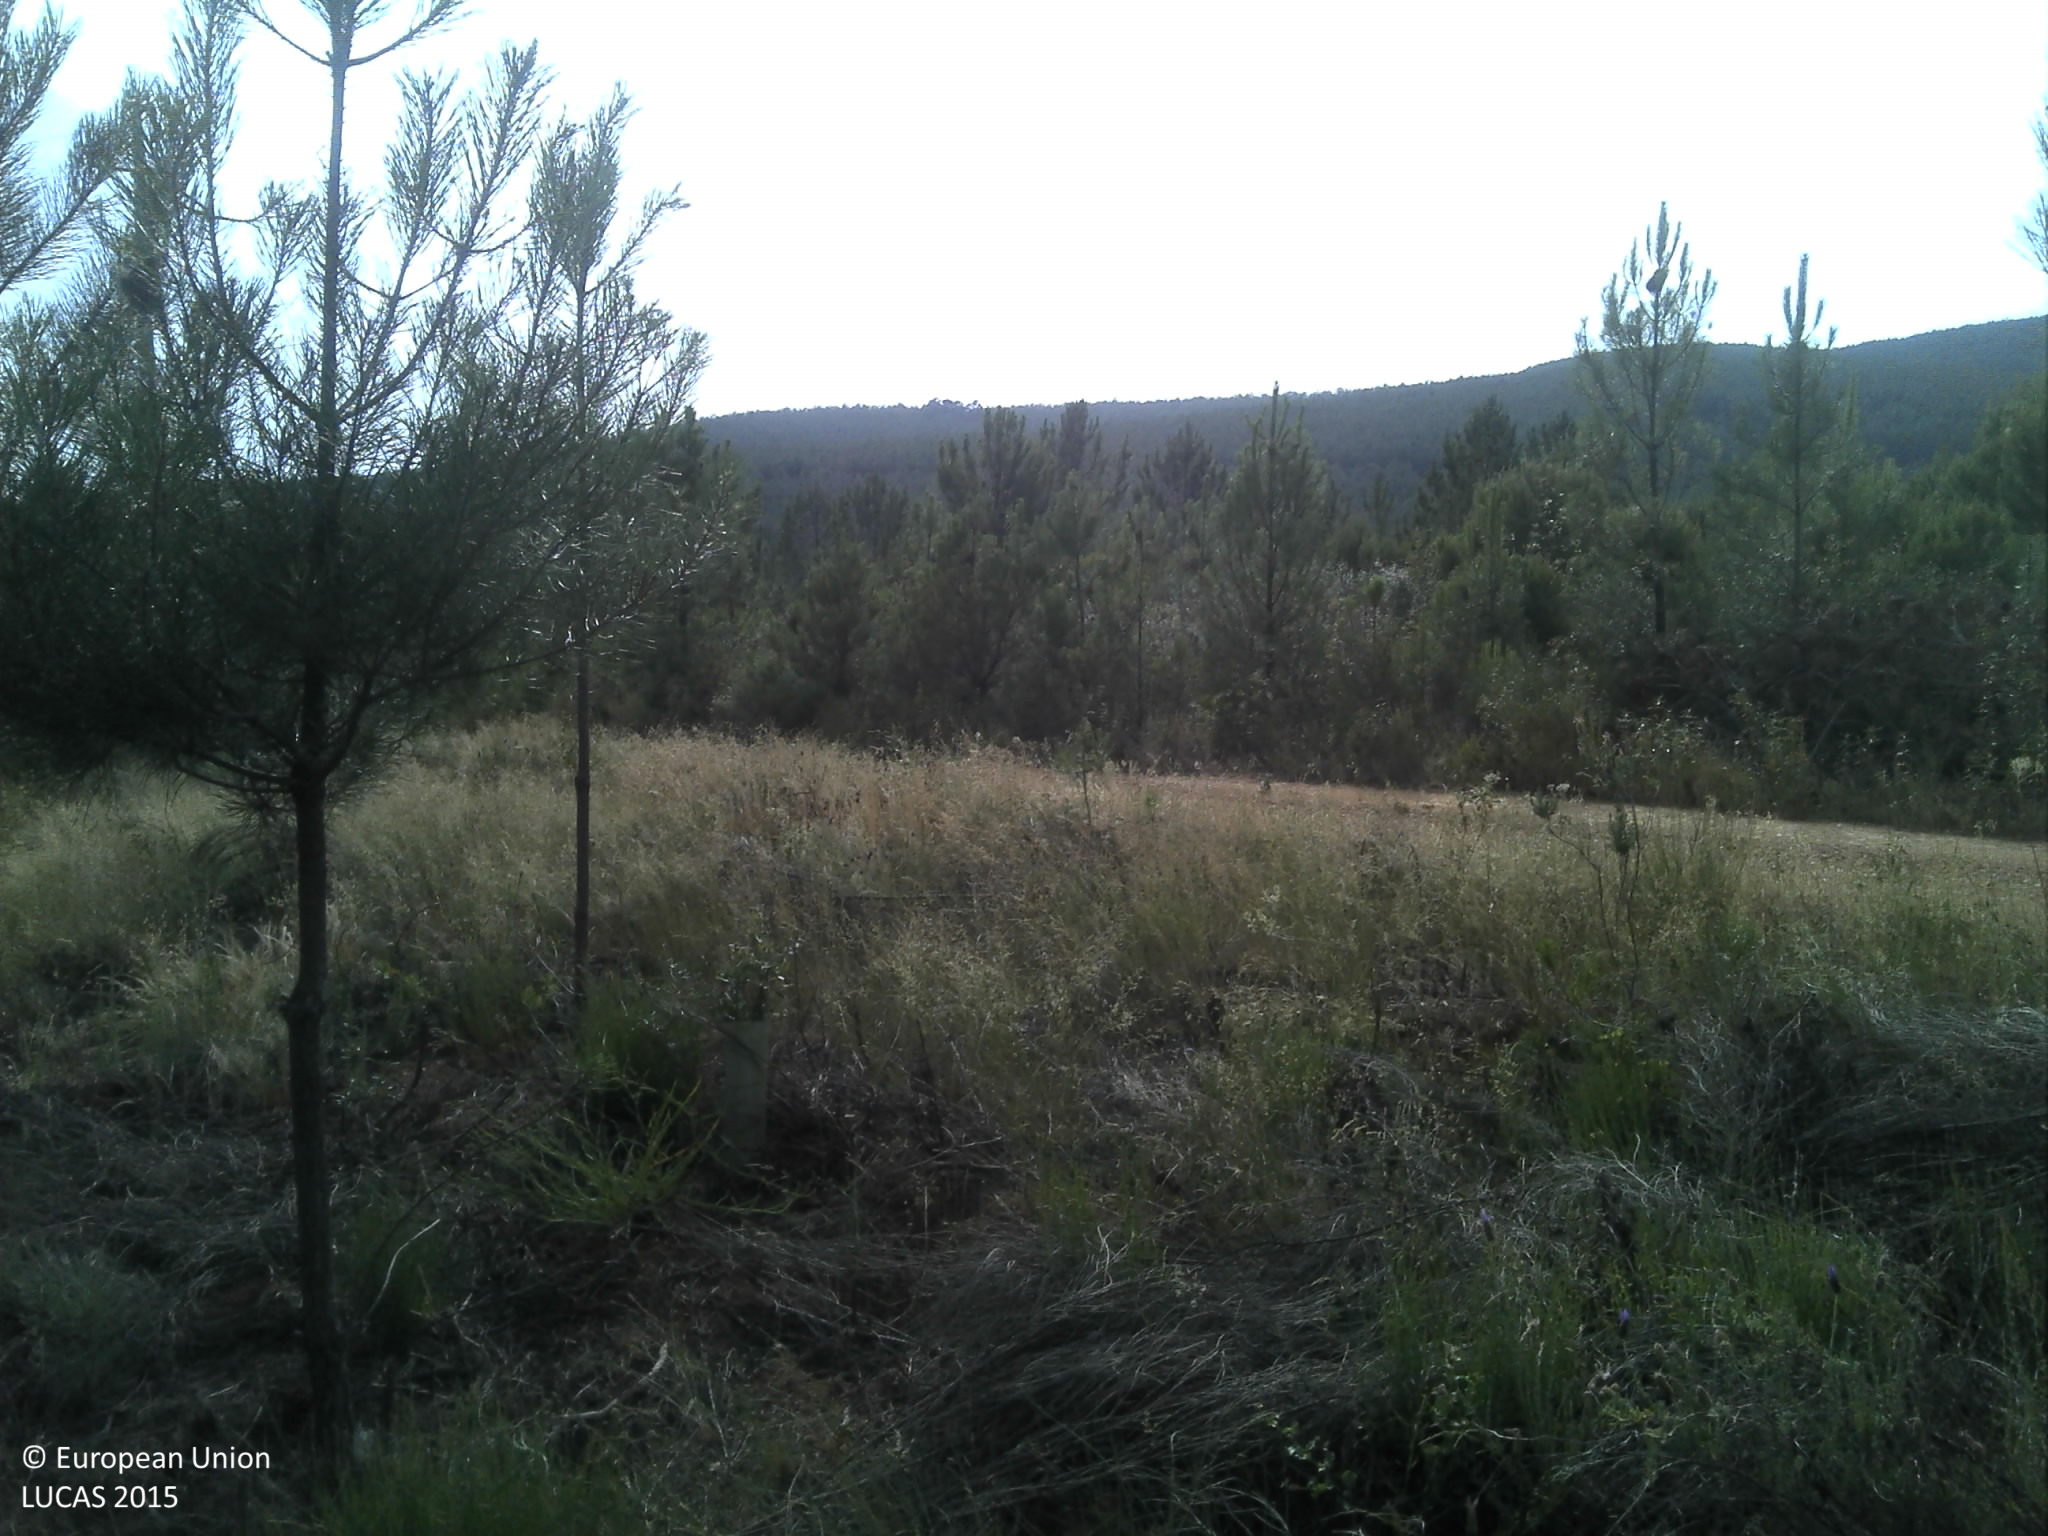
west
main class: Woodland
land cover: Pine dominated coniferous woodland
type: coniferous forest of the mediterranean region
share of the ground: 50 - 75 %
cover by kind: coniferous forest trees 50 %, shrubs 40 %, unconsolidated bare surface 5 %
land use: Forestry
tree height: > 5 m
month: June
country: PT
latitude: 40.2108
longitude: -7.0978
